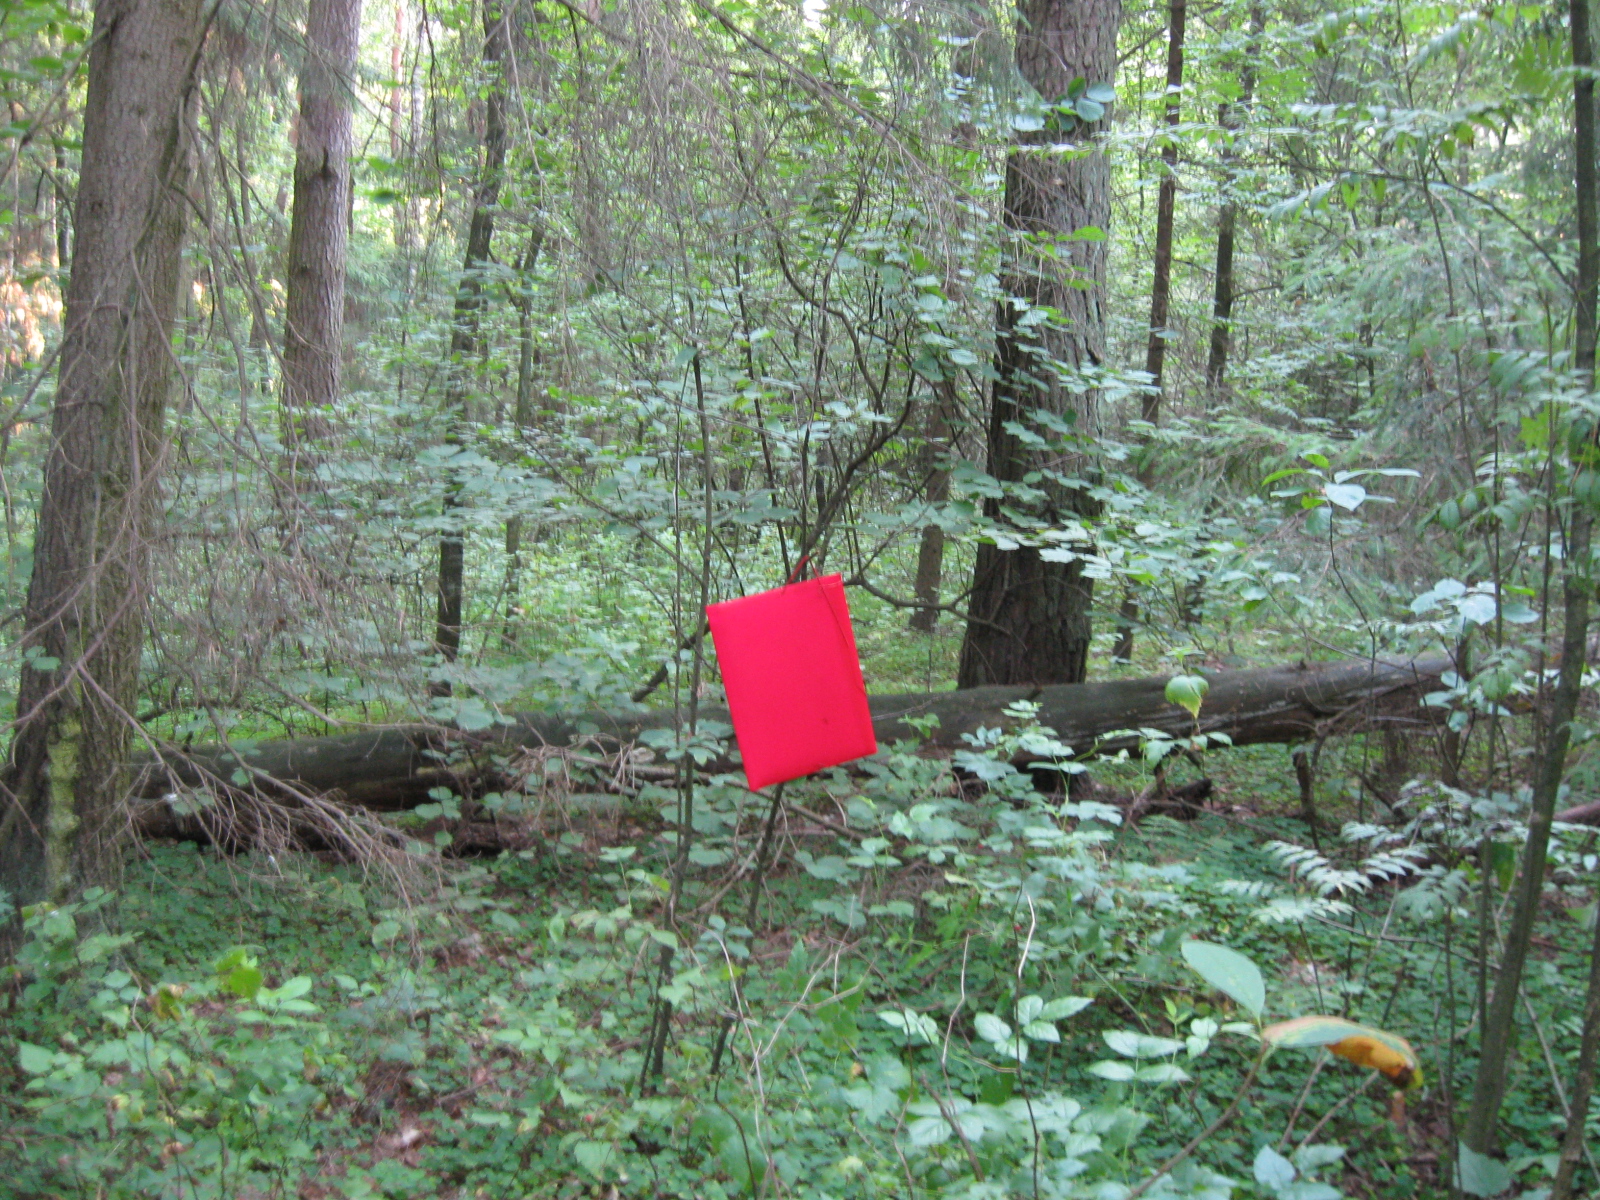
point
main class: Woodland
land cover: Other mixed woodland
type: hemiboreal forest and nemoral coniferous forest and mixed broadleaved-coniferous forest
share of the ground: > 75 %
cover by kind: coniferous forest trees 65 %, broadleaved forest trees 30 %, herbaceous plants 5 %
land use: Forestry
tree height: > 5 m
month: August
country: LT
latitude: 54.8107
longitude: 23.3507
